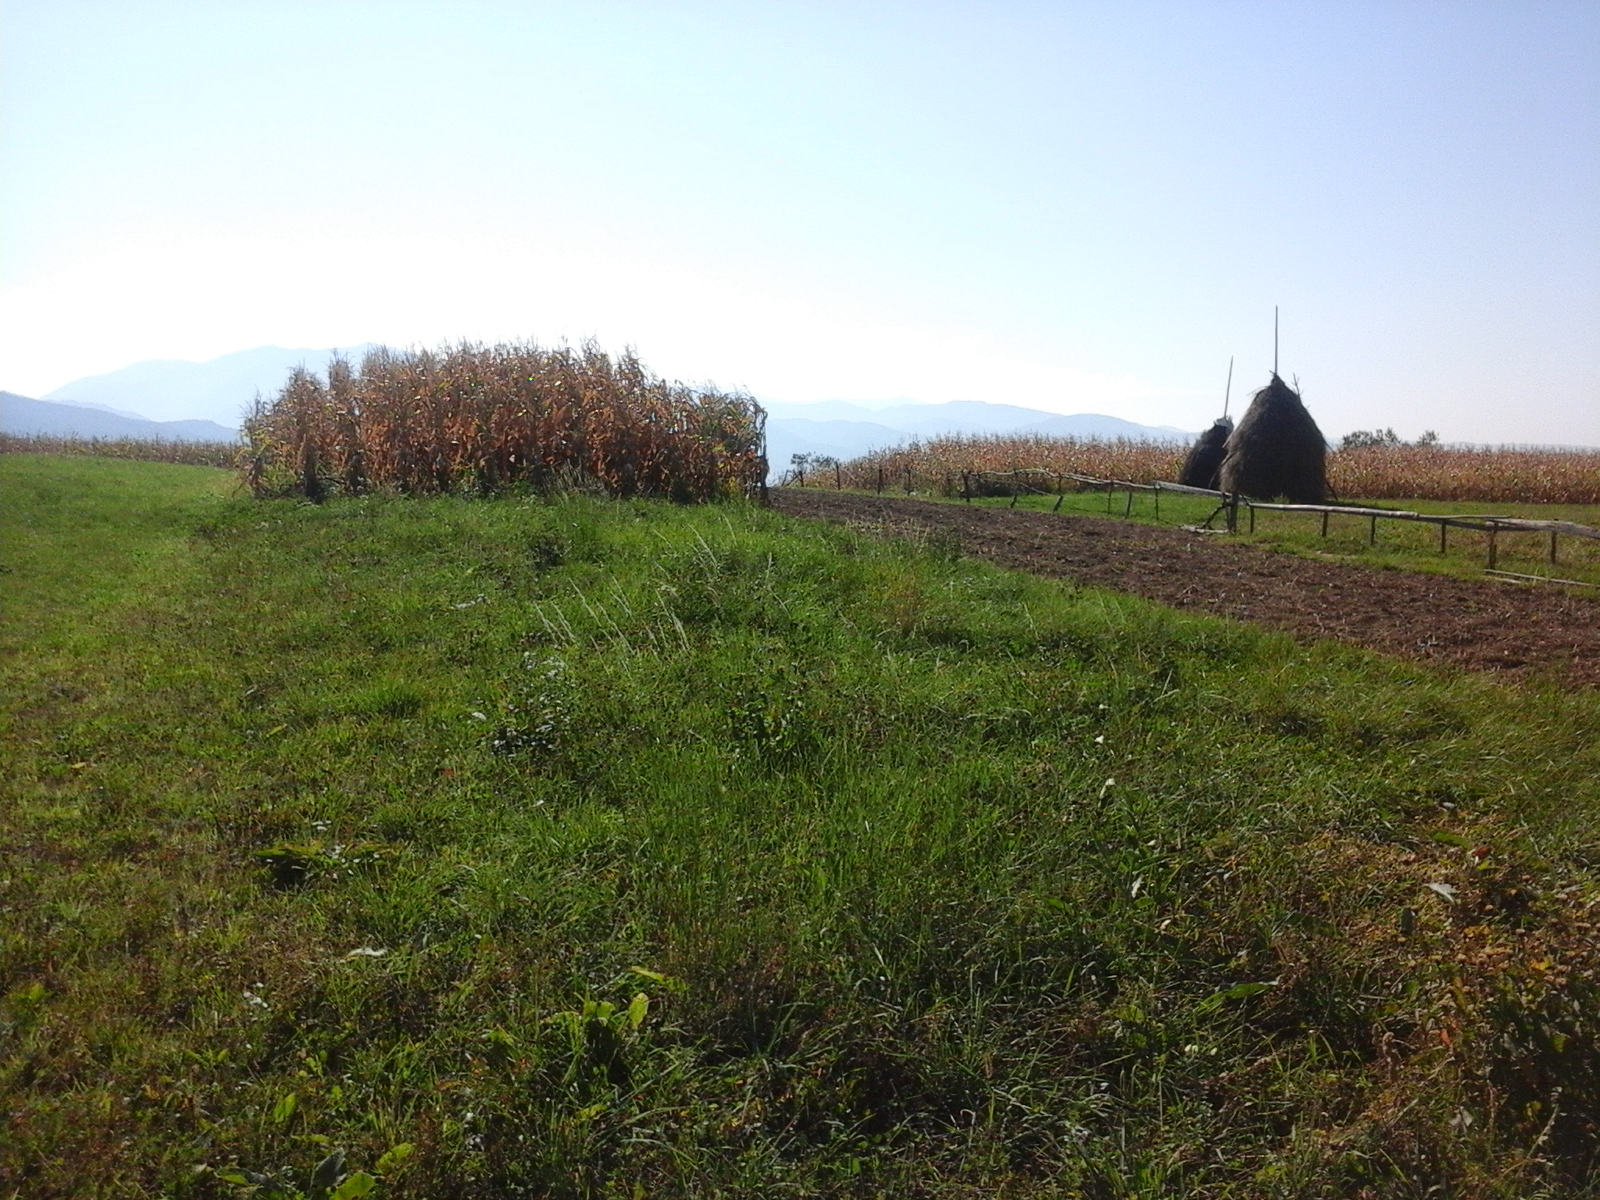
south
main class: Grassland
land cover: Grassland without tree/shrub cover
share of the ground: > 75 %
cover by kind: herbaceous plants 100 %
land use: Agriculture (excluding fallow land and kitchen gardens)
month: September
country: RO
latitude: 46.6316
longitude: 22.5266
